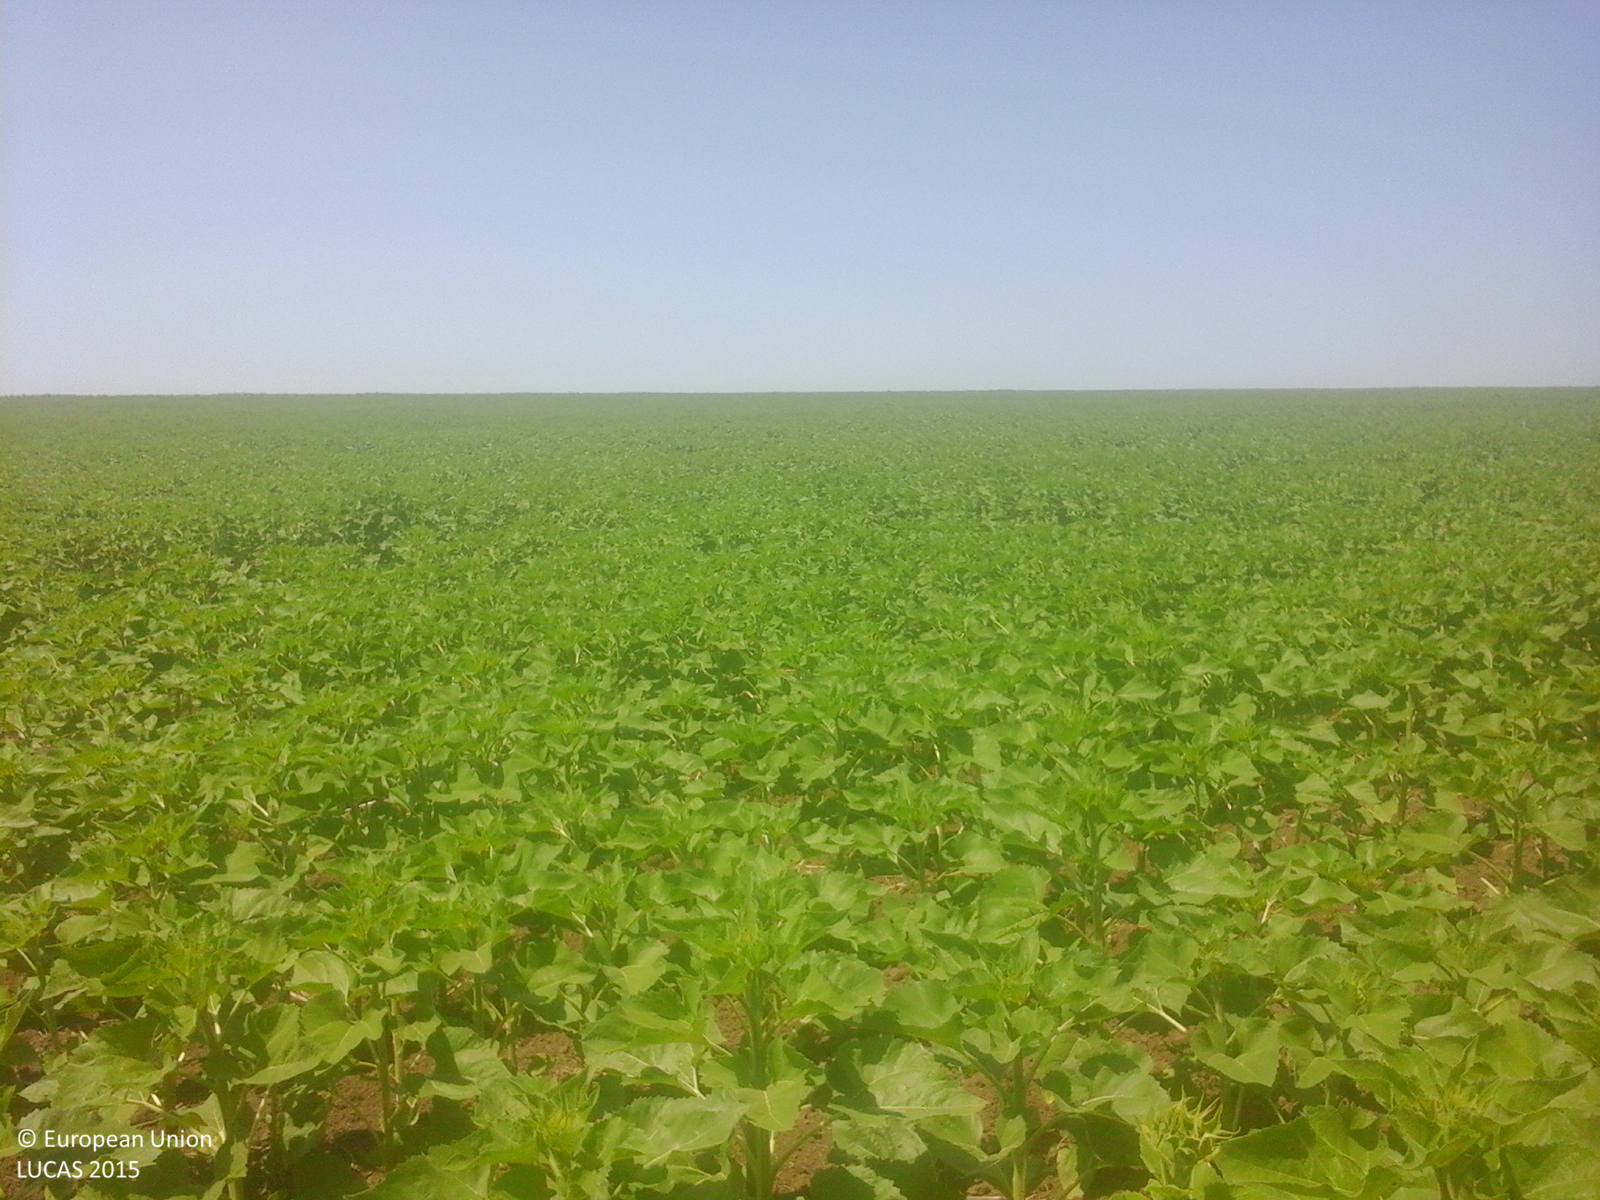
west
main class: Cropland
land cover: Sunflower
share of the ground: > 75 %
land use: Agriculture (excluding fallow land and kitchen gardens)
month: June
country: RO
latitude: 46.8391
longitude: 27.5403
